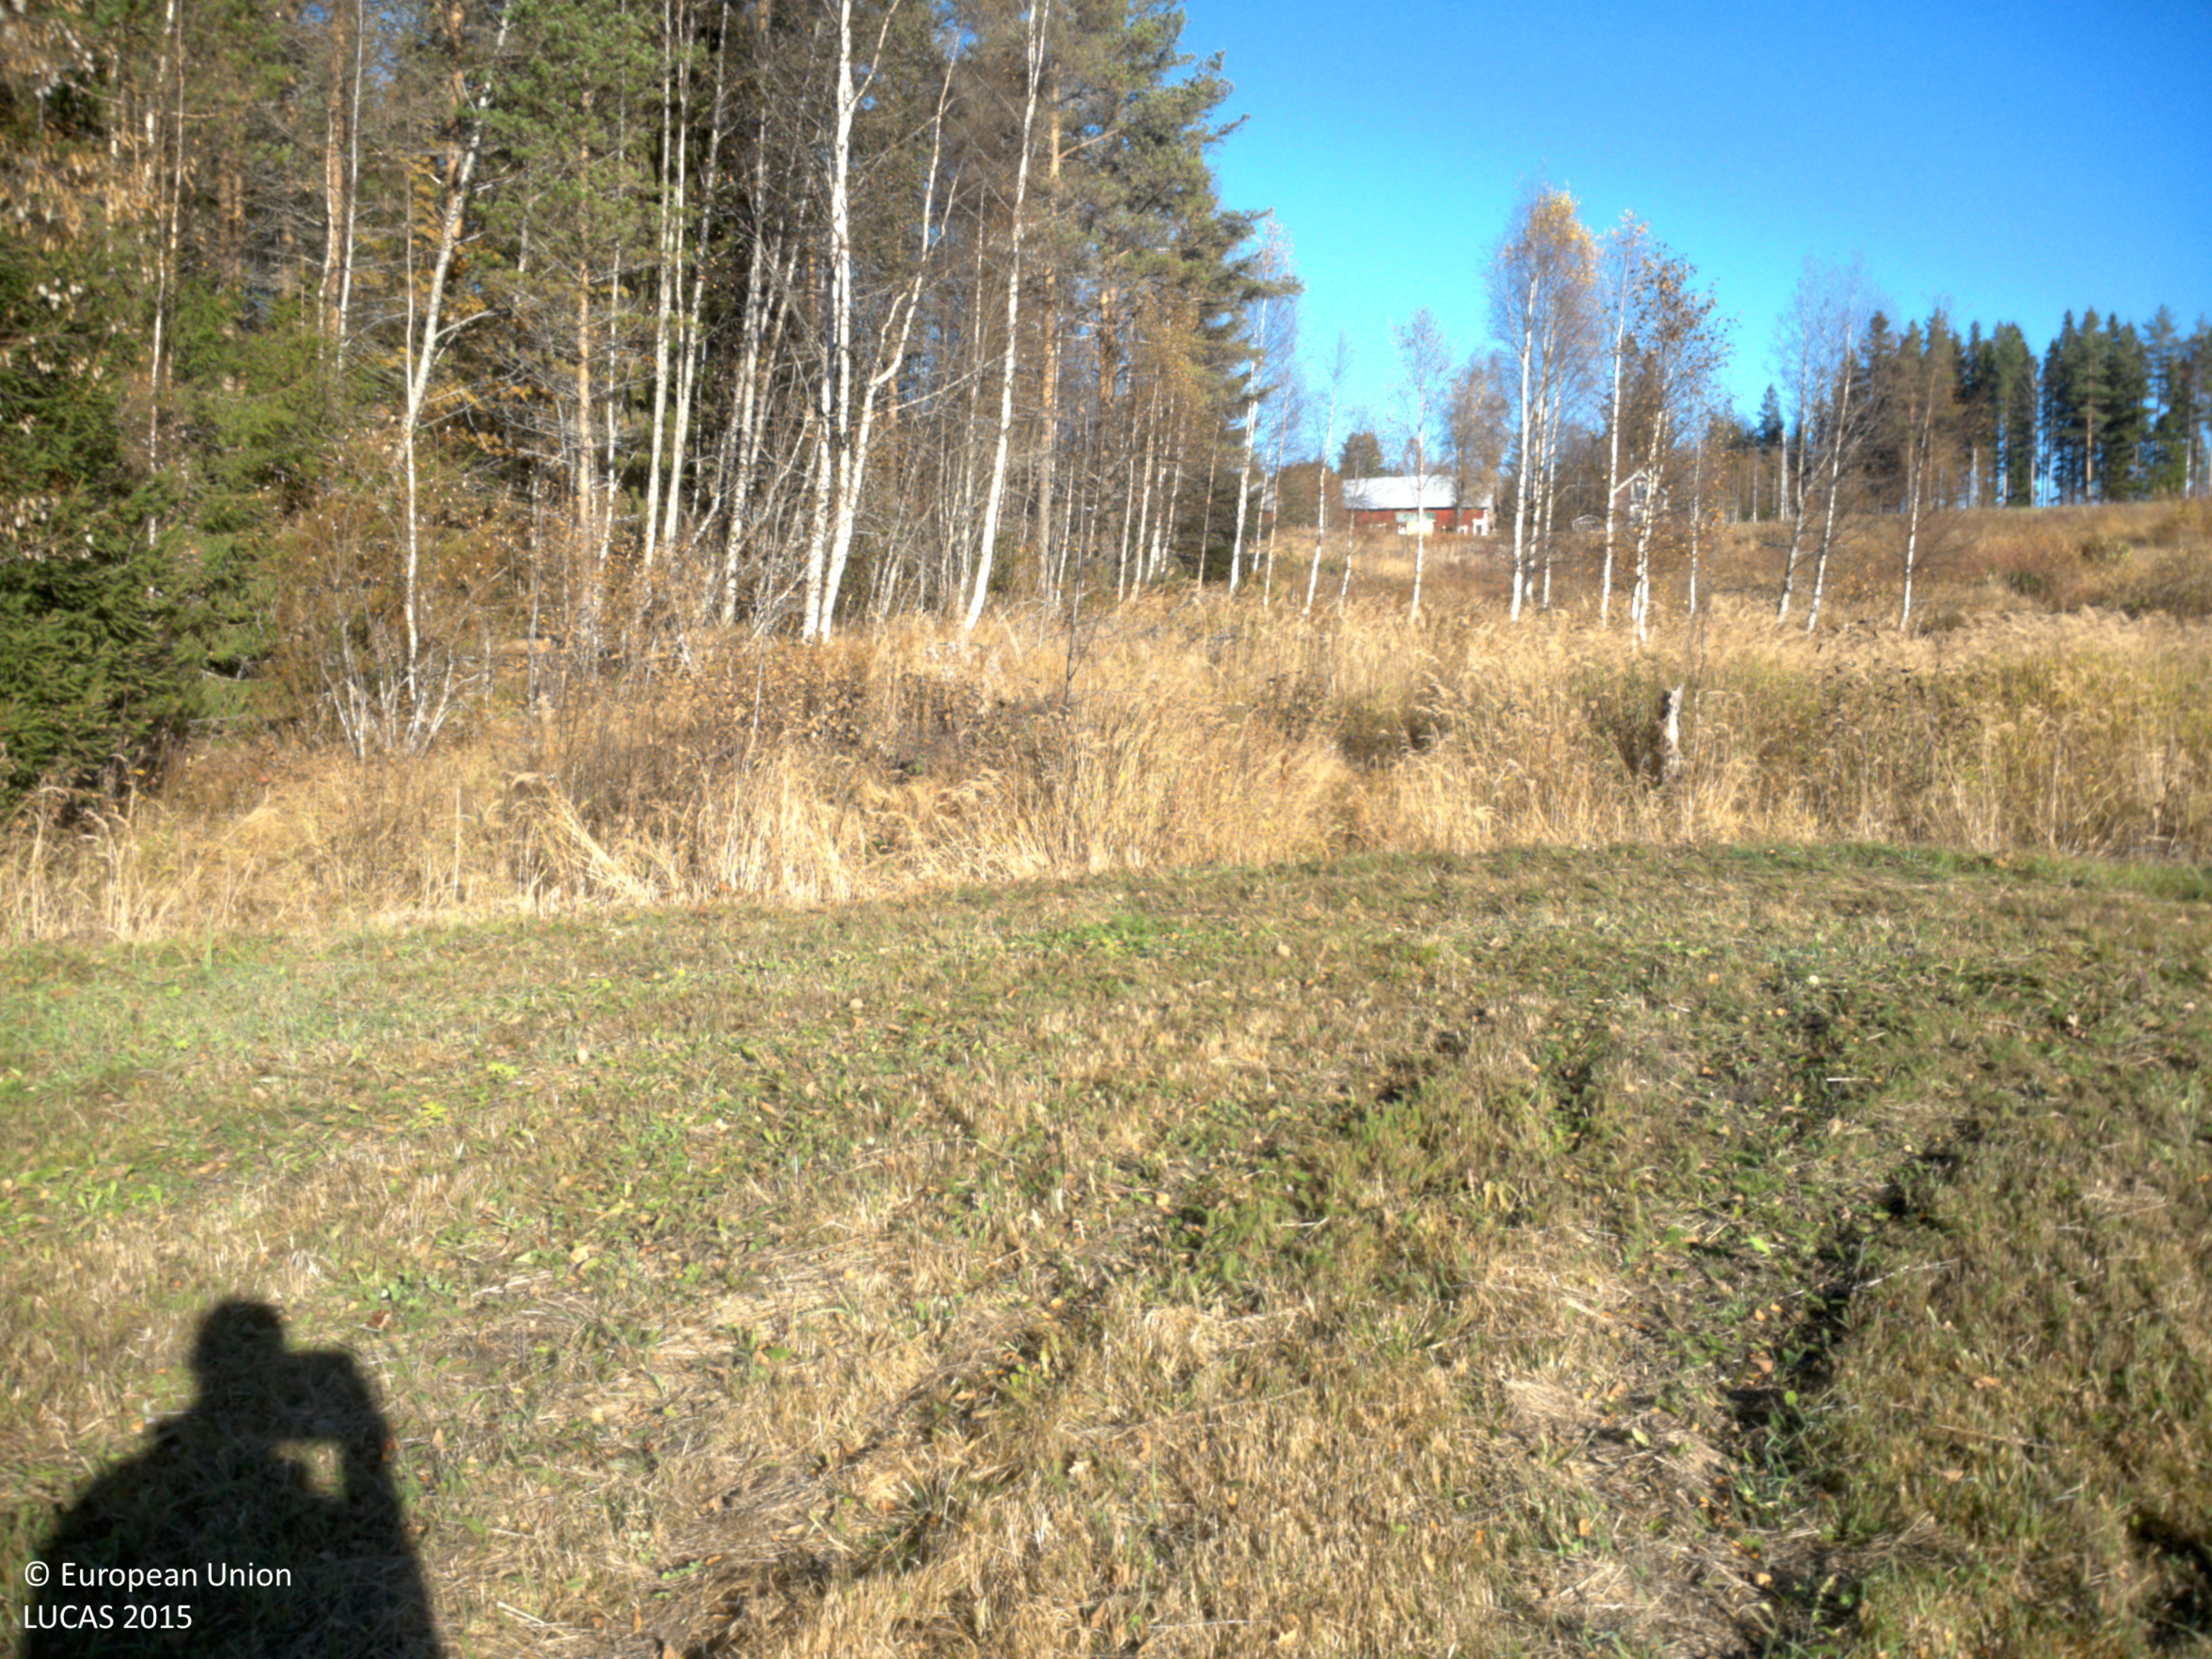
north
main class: Grassland
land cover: Grassland without tree/shrub cover
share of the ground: > 75 %
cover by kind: herbaceous plants 95 %, lichens and mosses 5 %
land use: Agriculture (excluding fallow land and kitchen gardens)
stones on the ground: < 10 %
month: October
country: SE
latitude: 64.0408
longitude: 19.7849
